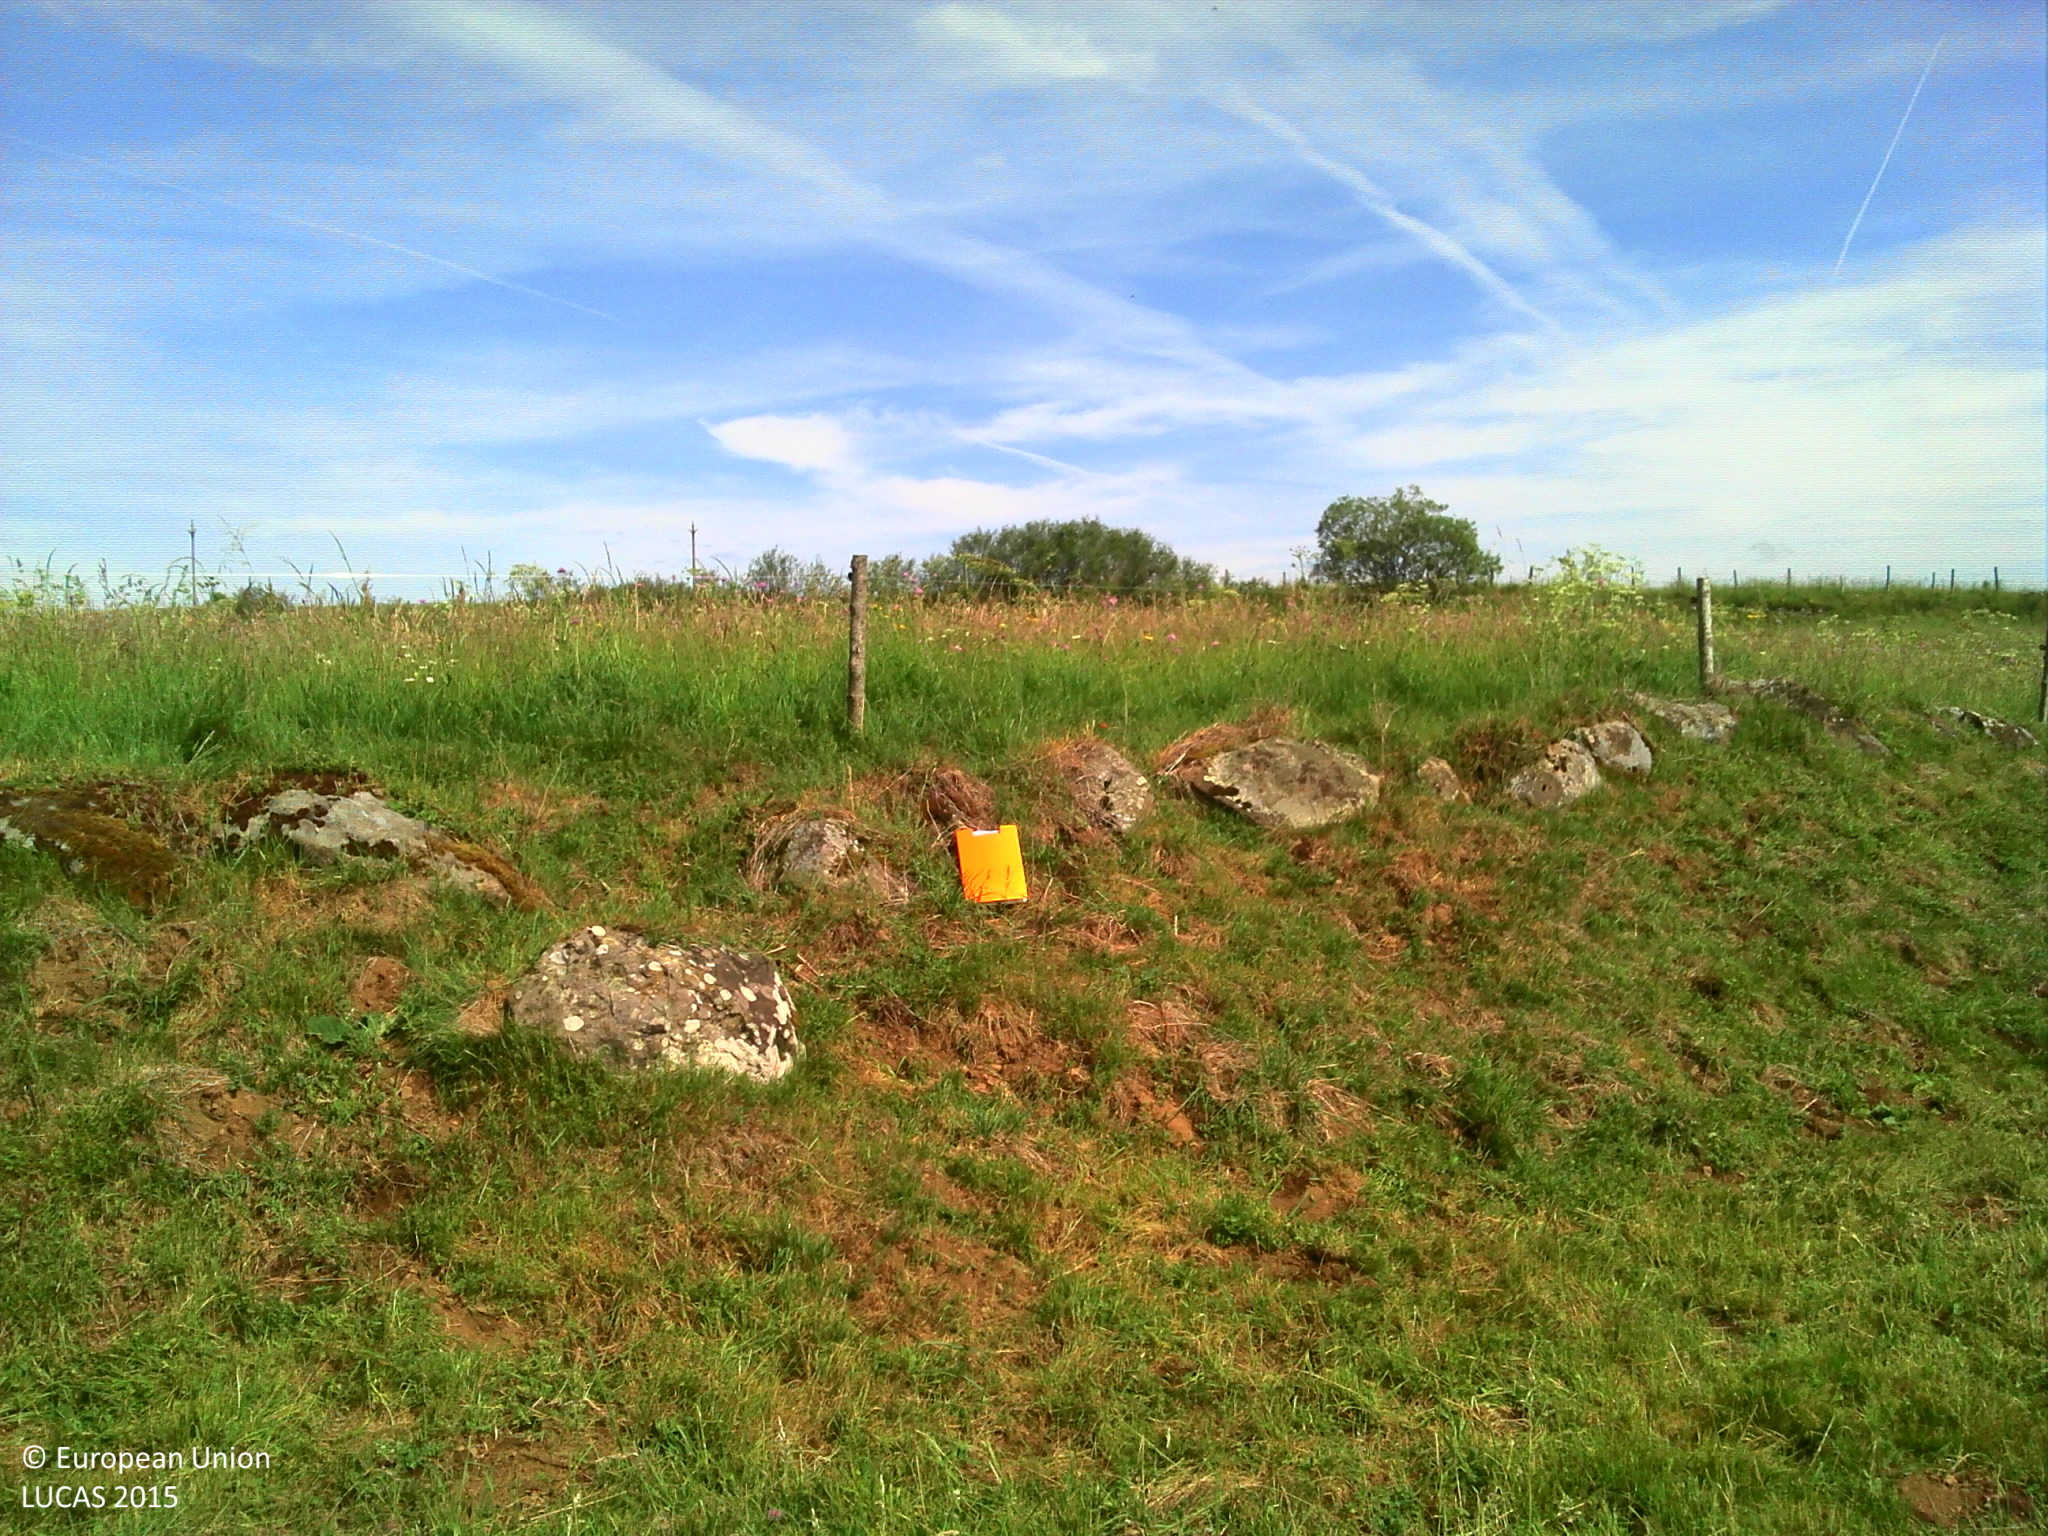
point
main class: Grassland
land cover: Grassland without tree/shrub cover
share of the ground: > 75 %
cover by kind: herbaceous plants 100 %
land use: Agriculture (excluding fallow land and kitchen gardens)
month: June
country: FR
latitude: 45.1398
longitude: 2.9181
